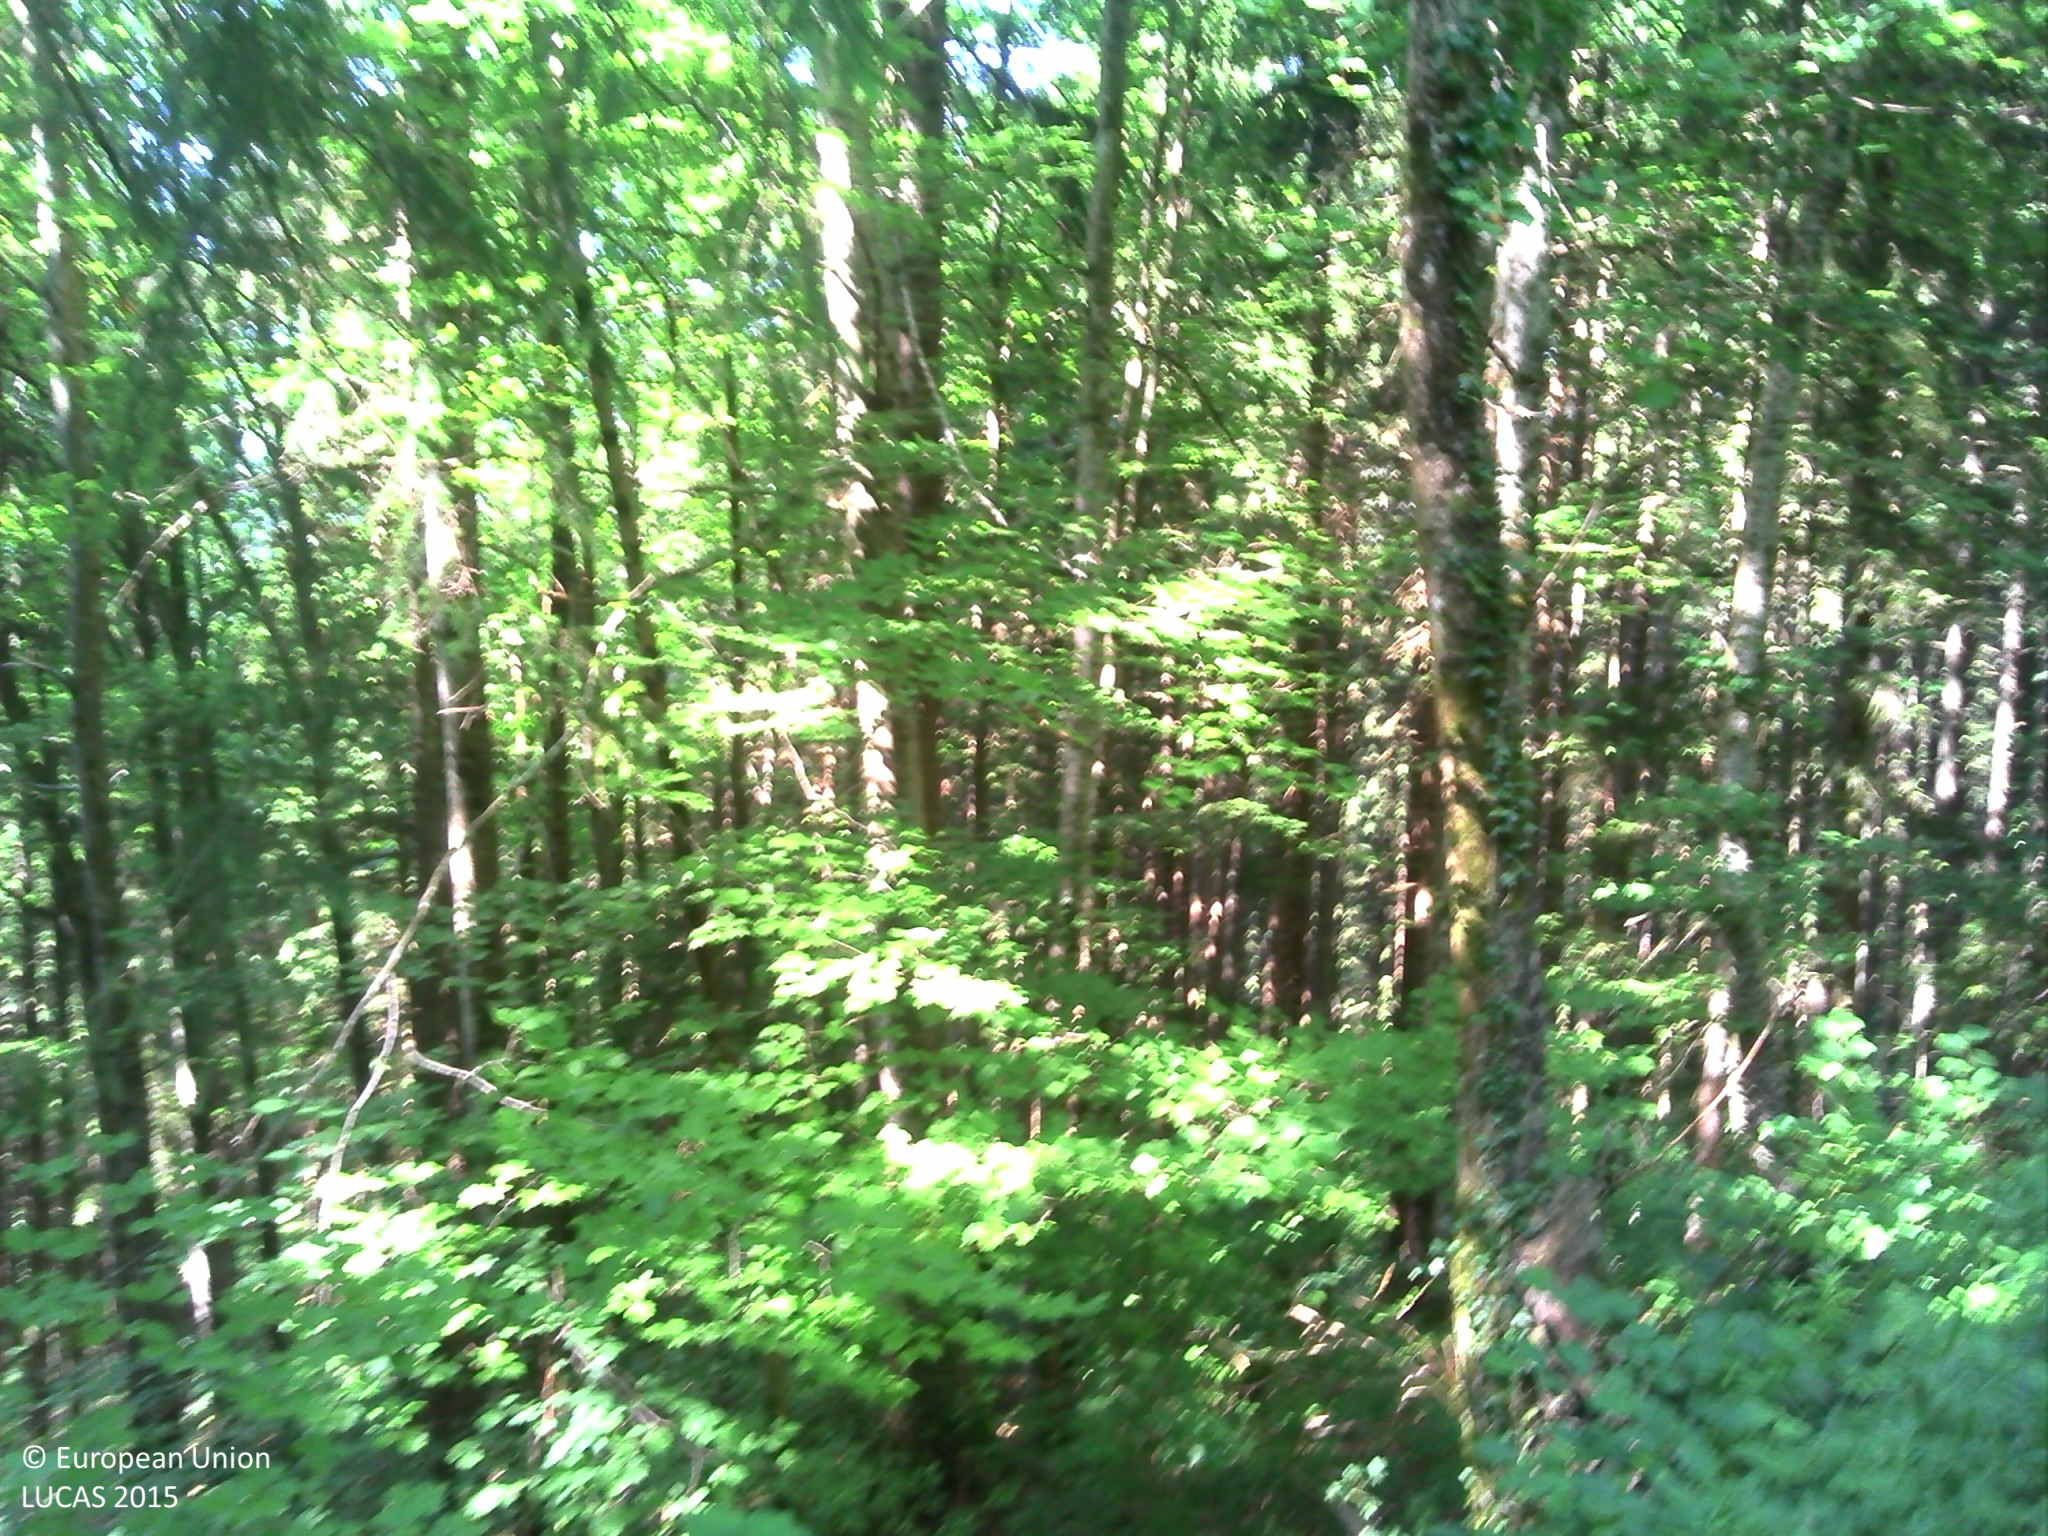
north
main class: Woodland
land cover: Spruce dominated coniferous woodland
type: hemiboreal forest and nemoral coniferous forest and mixed broadleaved-coniferous forest
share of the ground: > 75 %
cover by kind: coniferous forest trees 95 %, unconsolidated bare surface 5 %
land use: Forestry
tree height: > 5 m
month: June
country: FR
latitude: 45.0823
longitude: 5.4702
